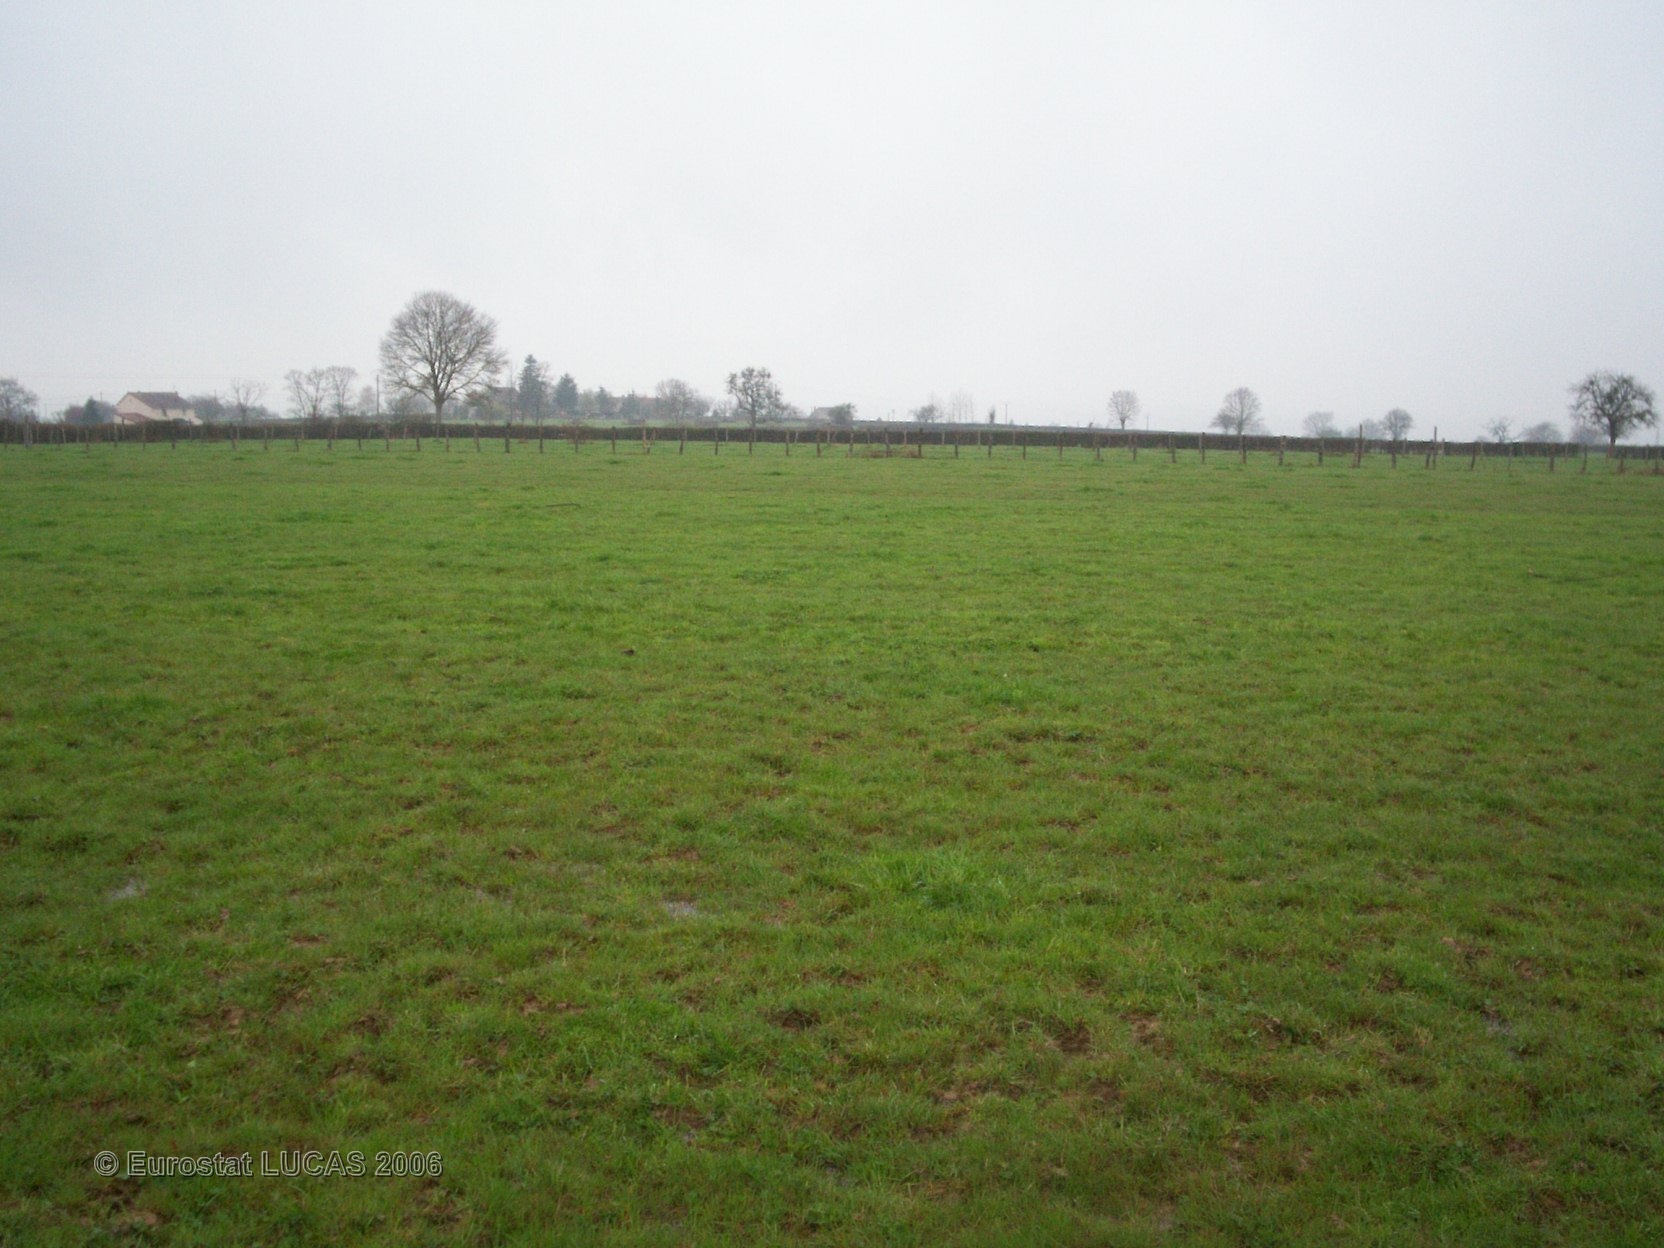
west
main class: Grassland
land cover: Grassland without tree/shrub cover
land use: Agriculture (excluding fallow land and kitchen gardens)
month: April
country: FR
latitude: 46.2770
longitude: 4.0703
